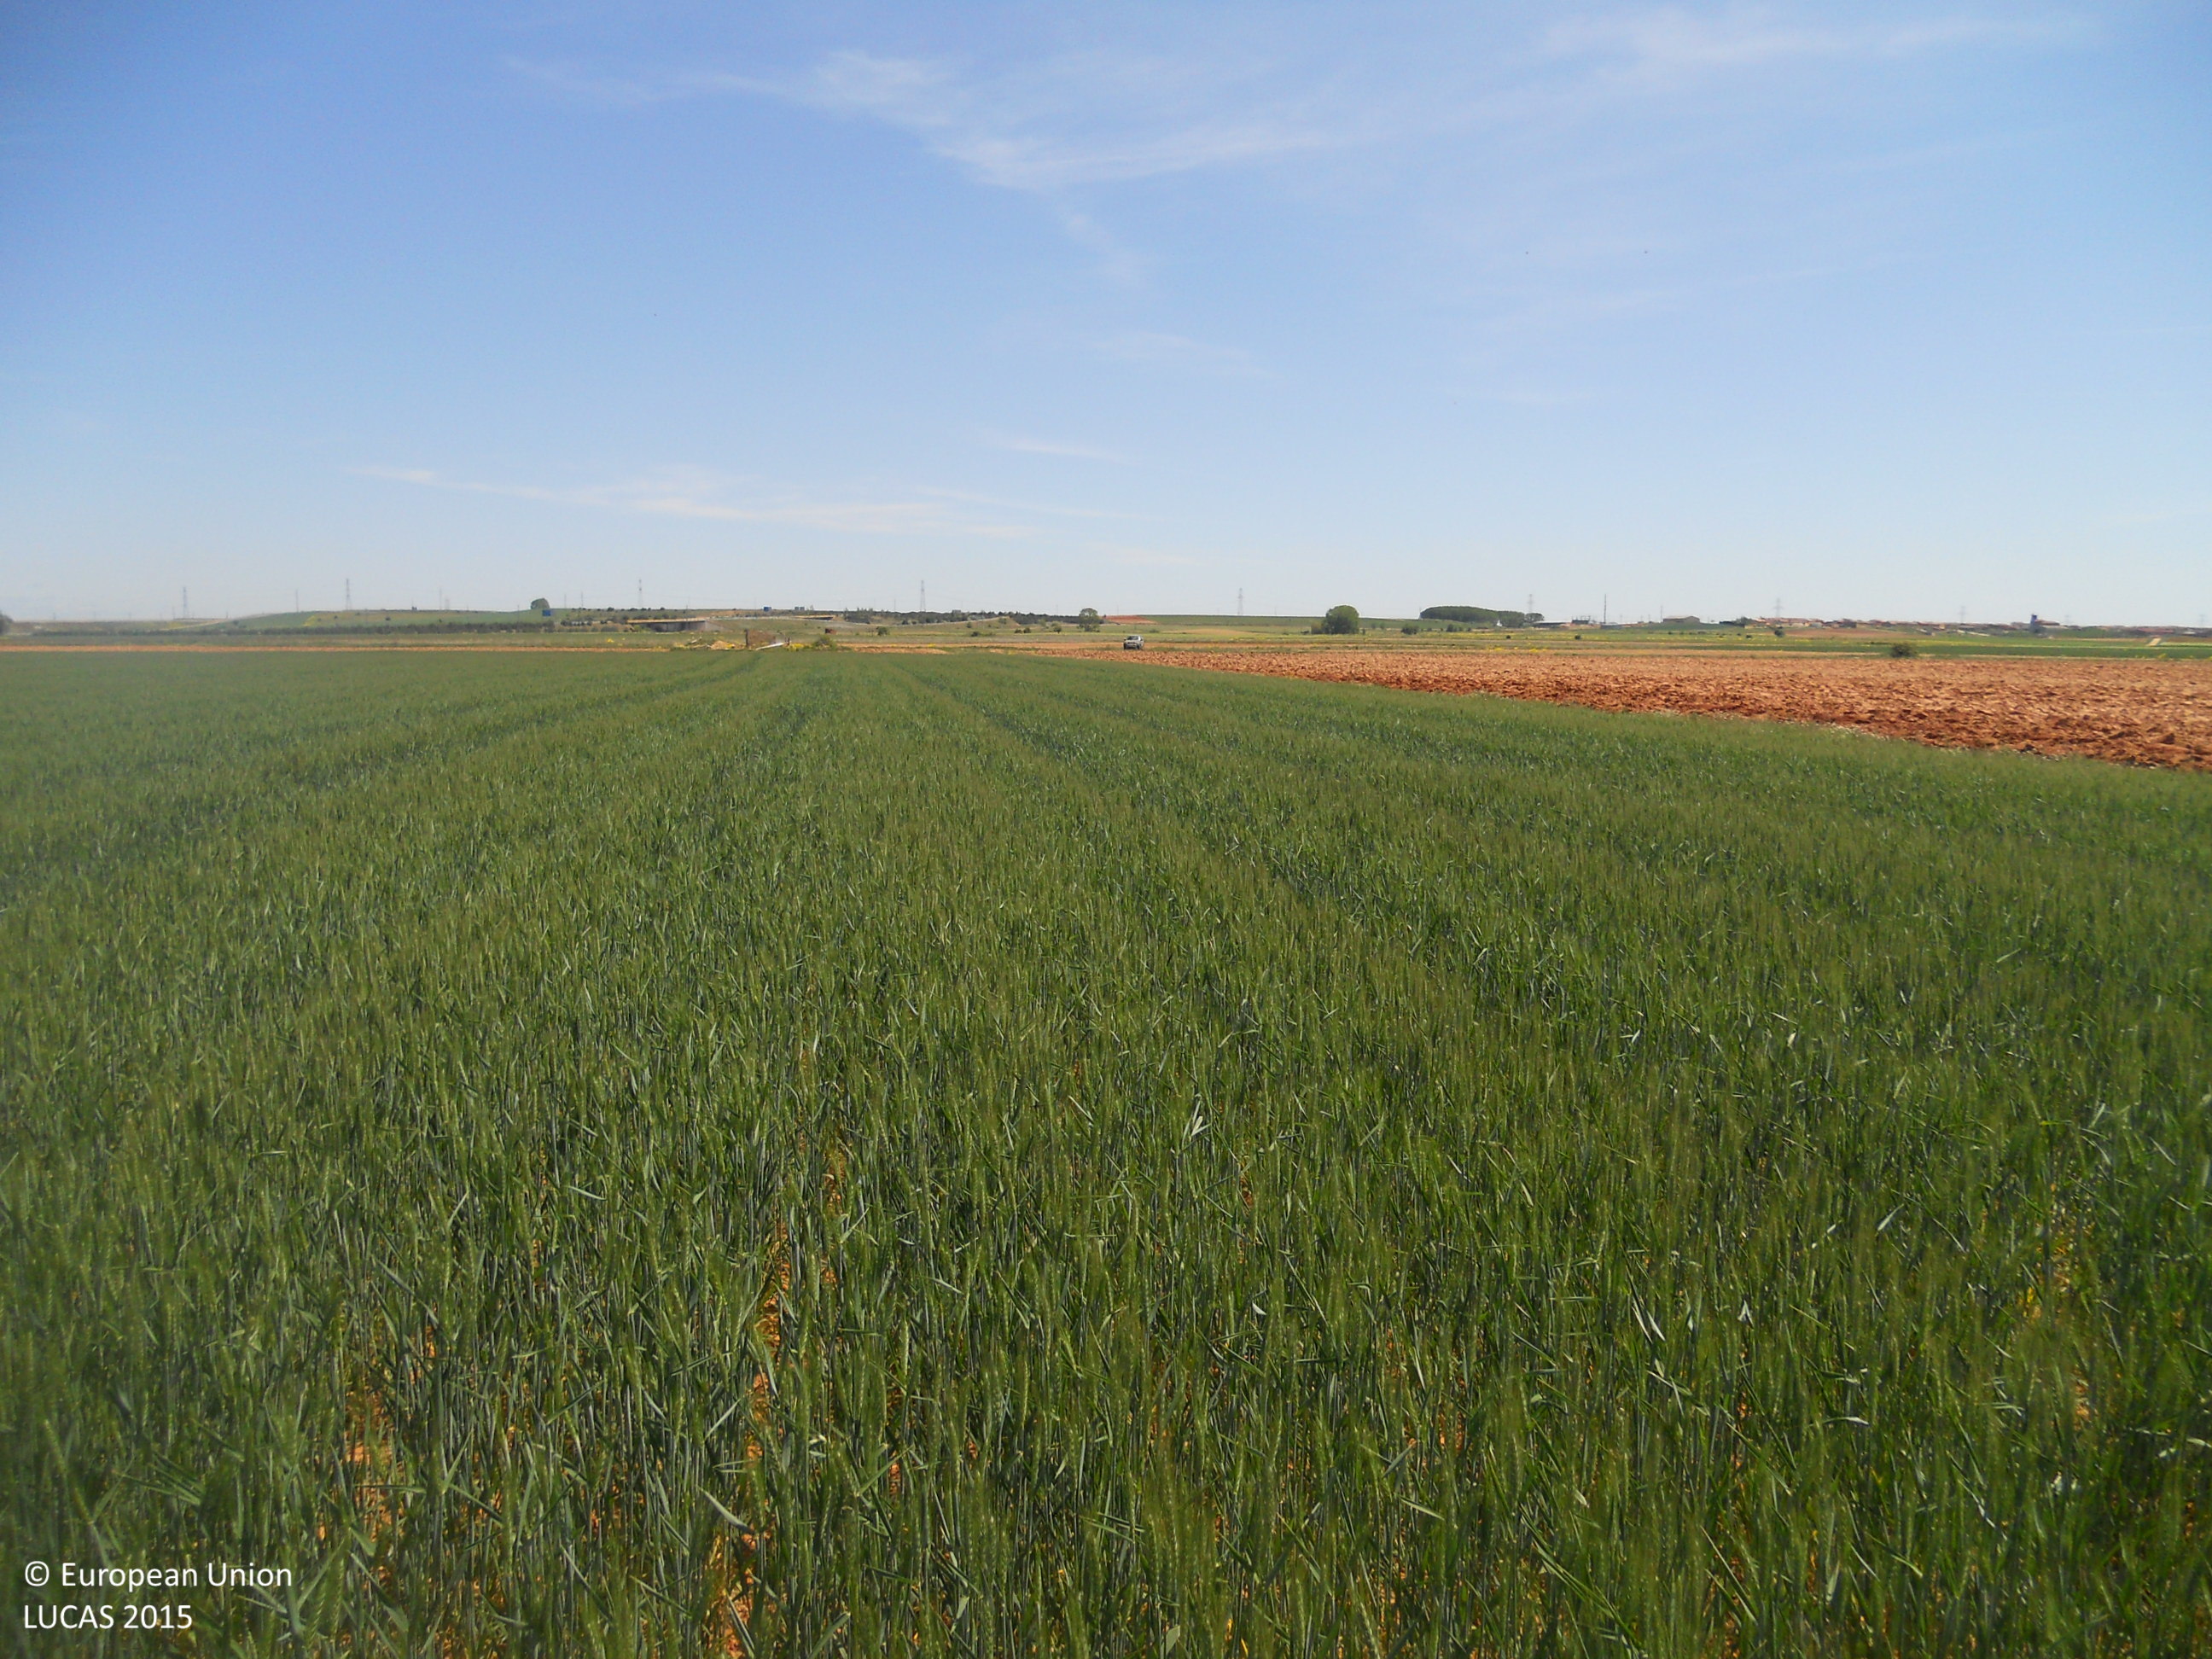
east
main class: Cropland
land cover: Durum wheat
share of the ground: > 75 %
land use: Agriculture (excluding fallow land and kitchen gardens)
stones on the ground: < 10 %
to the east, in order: Durum wheat; Other bare soil; Grass margins; Tracks; Grass margins; Other bare soil; Grass margins; Tracks; Grassland without tree/shrub cover; Other bare soil
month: May
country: ES
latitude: 42.4411
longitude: -5.3974
